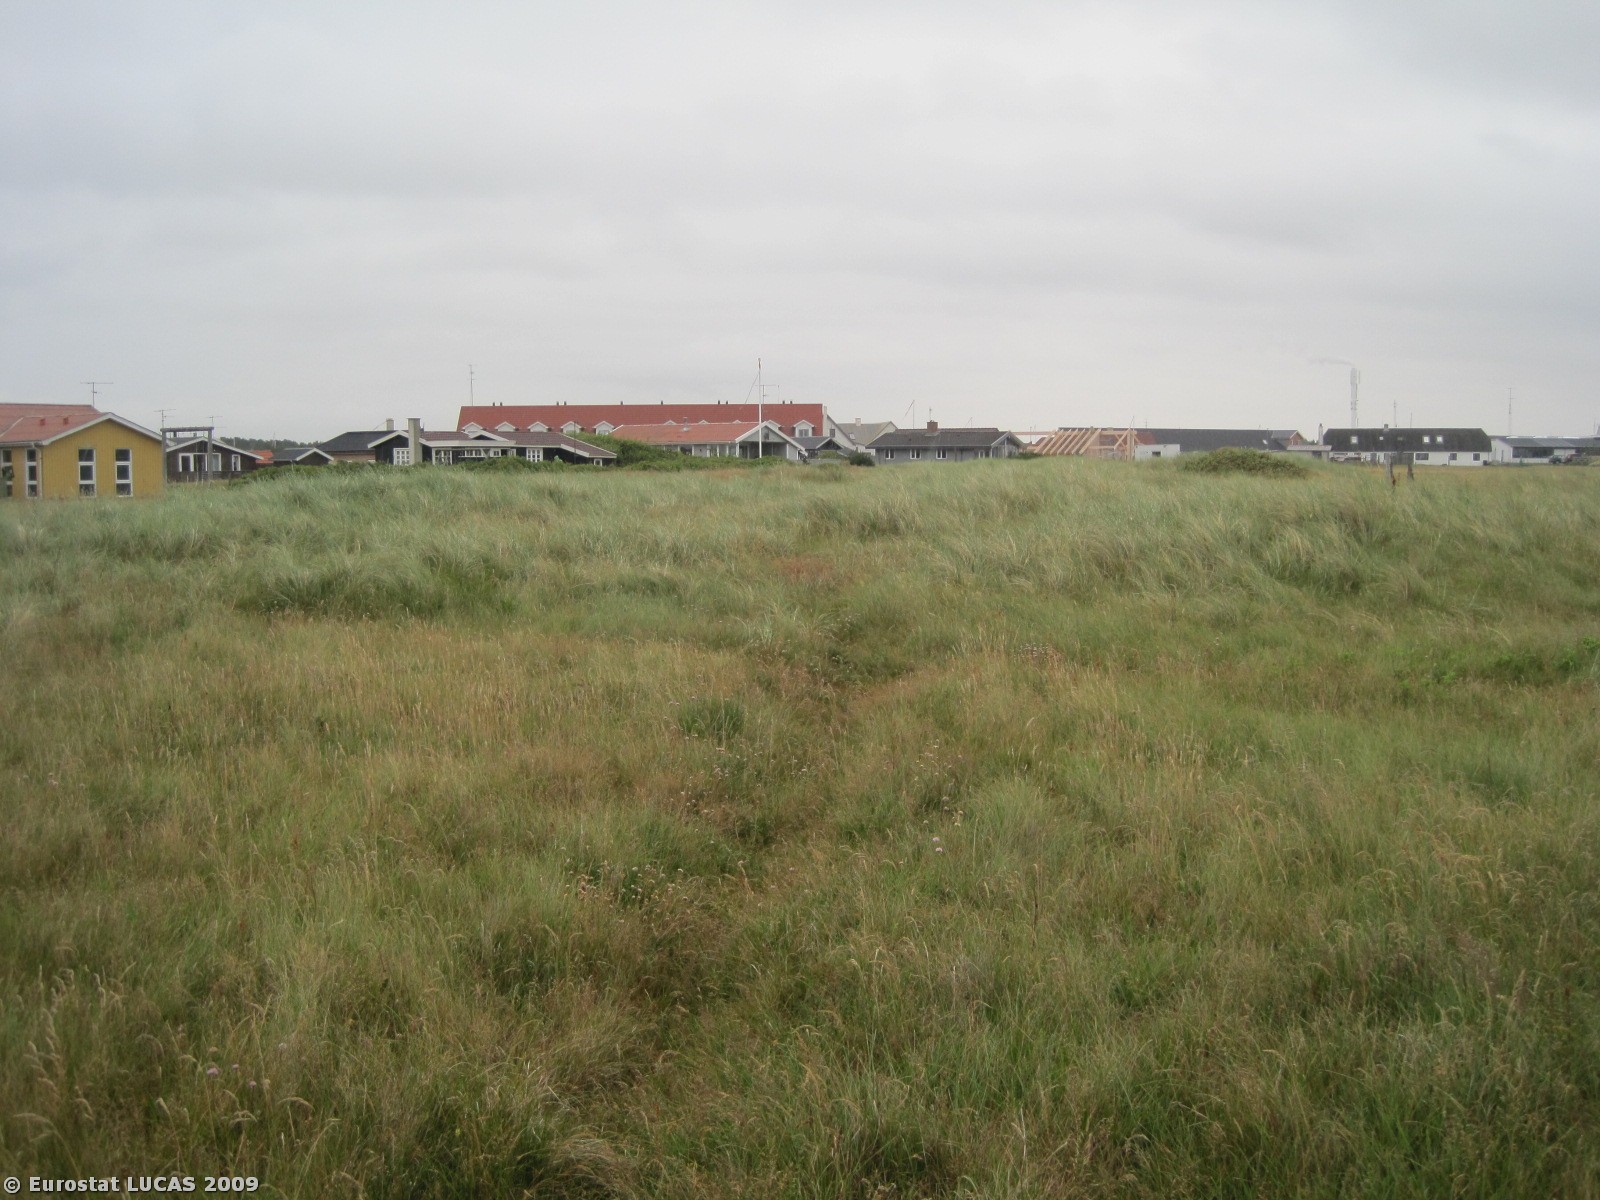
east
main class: Grassland
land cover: Grassland without tree/shrub cover
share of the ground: > 75 %
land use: Amenities, museums, leisure
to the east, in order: Grassland without tree/shrub cover; Artificial constructions in urban areas; Grassland without tree/shrub cover; Tracks; Grassland without tree/shrub cover; Artificial constructions in urban areas; Grassland without tree/shrub cover; Artificial constructions in urban areas; Fences; Grassland without tree/shrub cover; Fences; Grassland without tree/shrub cover; Fences; Artificial constructions in urban areas
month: July
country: DK
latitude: 57.0421
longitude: 8.5024
